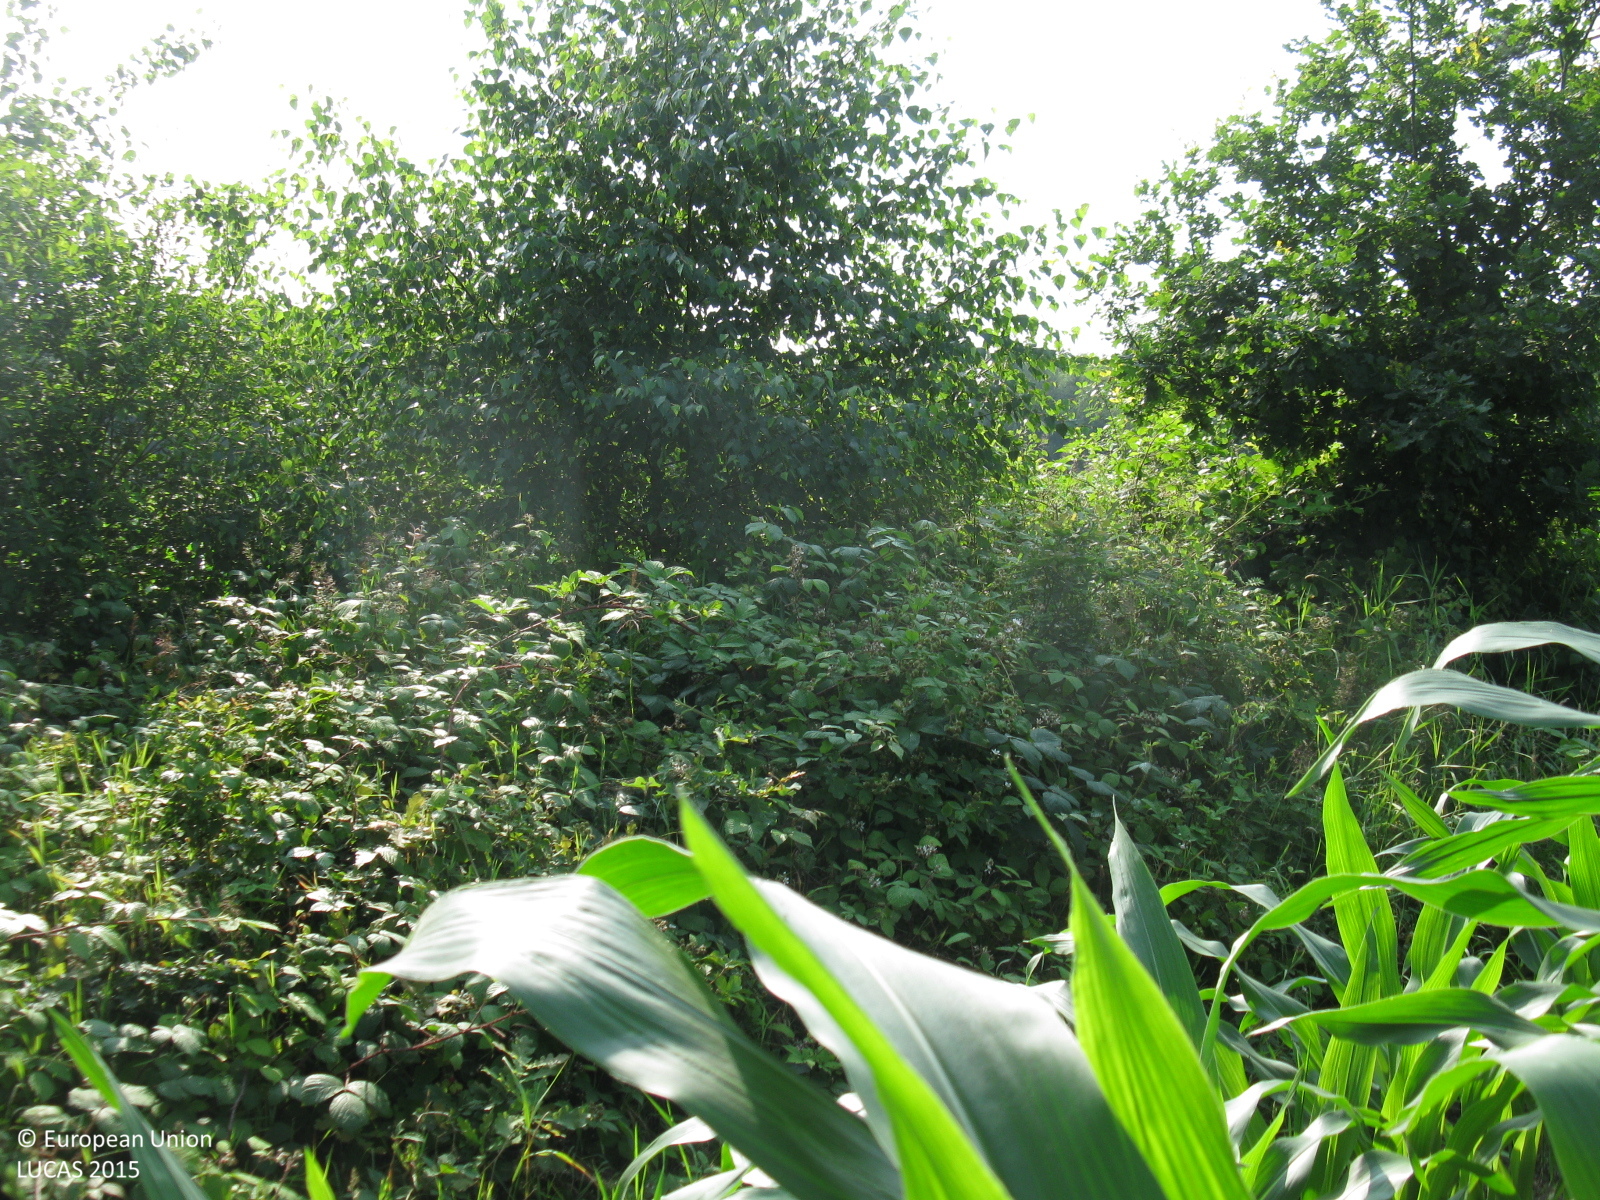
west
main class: Cropland
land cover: Maize
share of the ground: > 75 %
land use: Agriculture (excluding fallow land and kitchen gardens)
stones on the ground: < 10 %
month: July
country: DE
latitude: 53.2043
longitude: 7.9196
